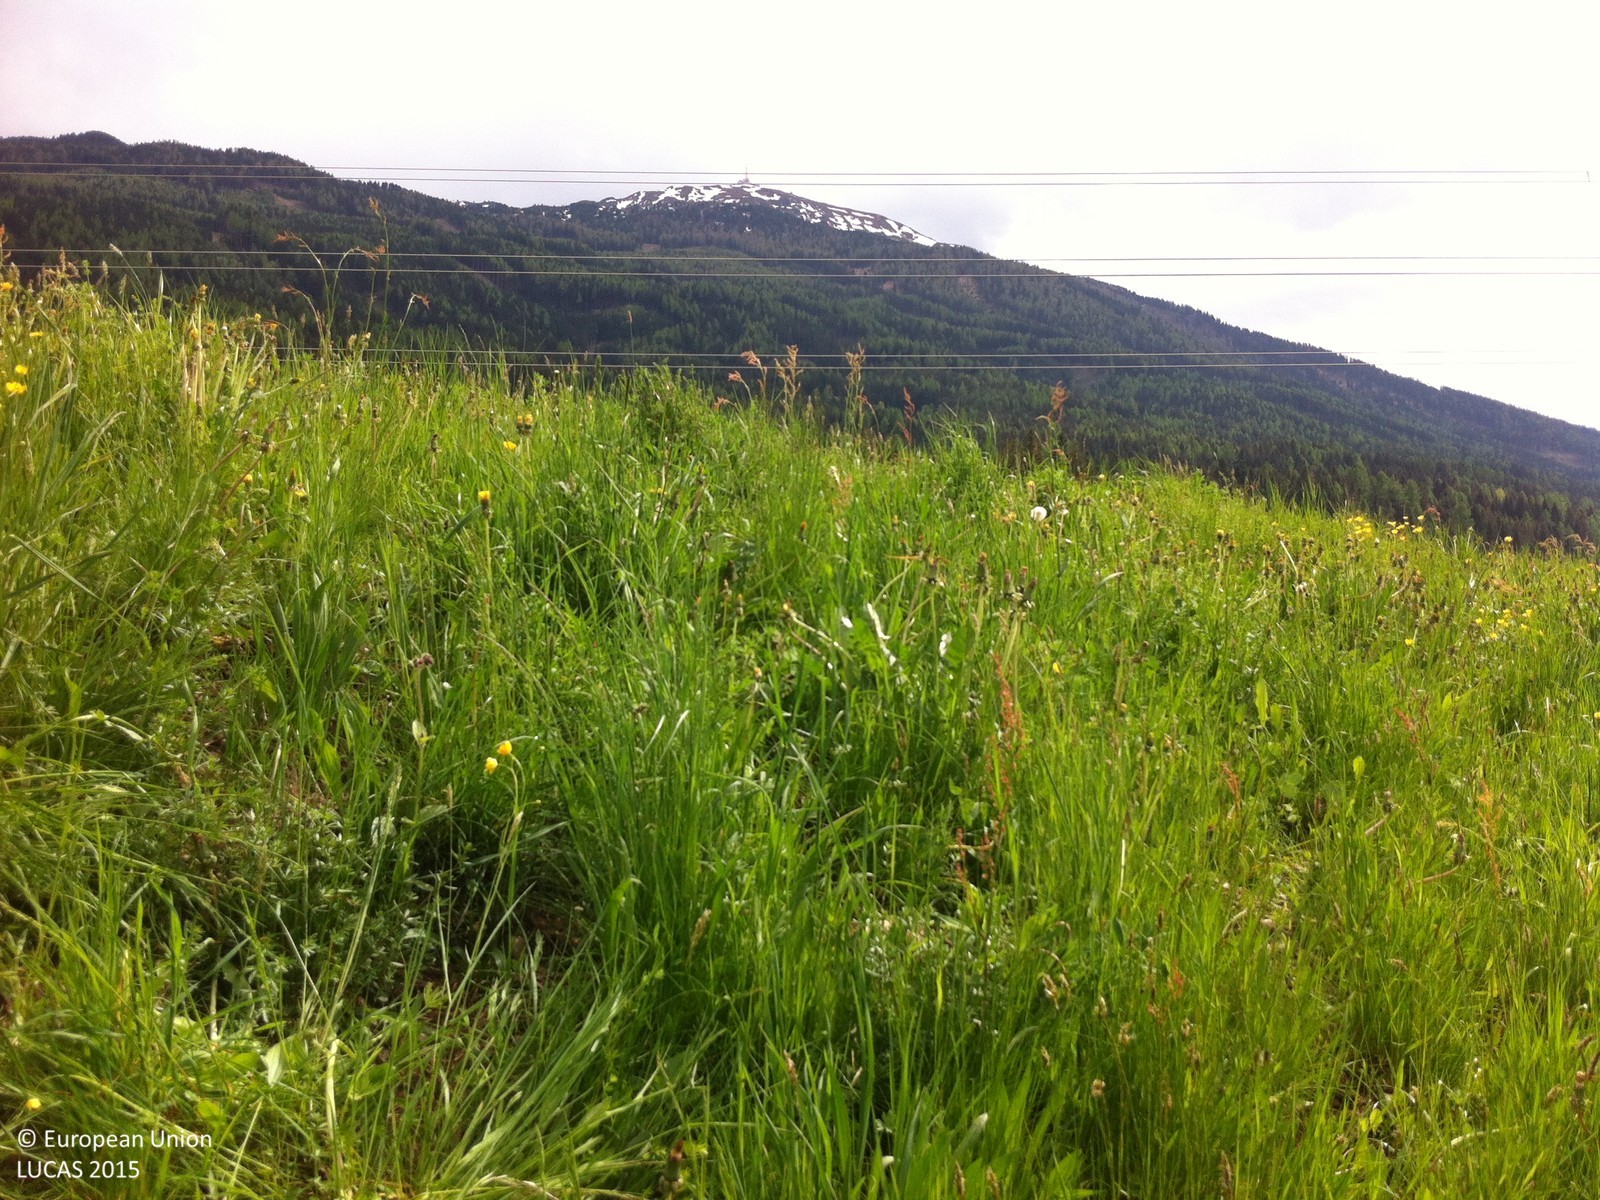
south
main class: Grassland
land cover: Grassland without tree/shrub cover
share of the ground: > 75 %
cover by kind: herbaceous plants 100 %
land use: Agriculture (excluding fallow land and kitchen gardens)
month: May
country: AT
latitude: 47.2417
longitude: 11.4650
